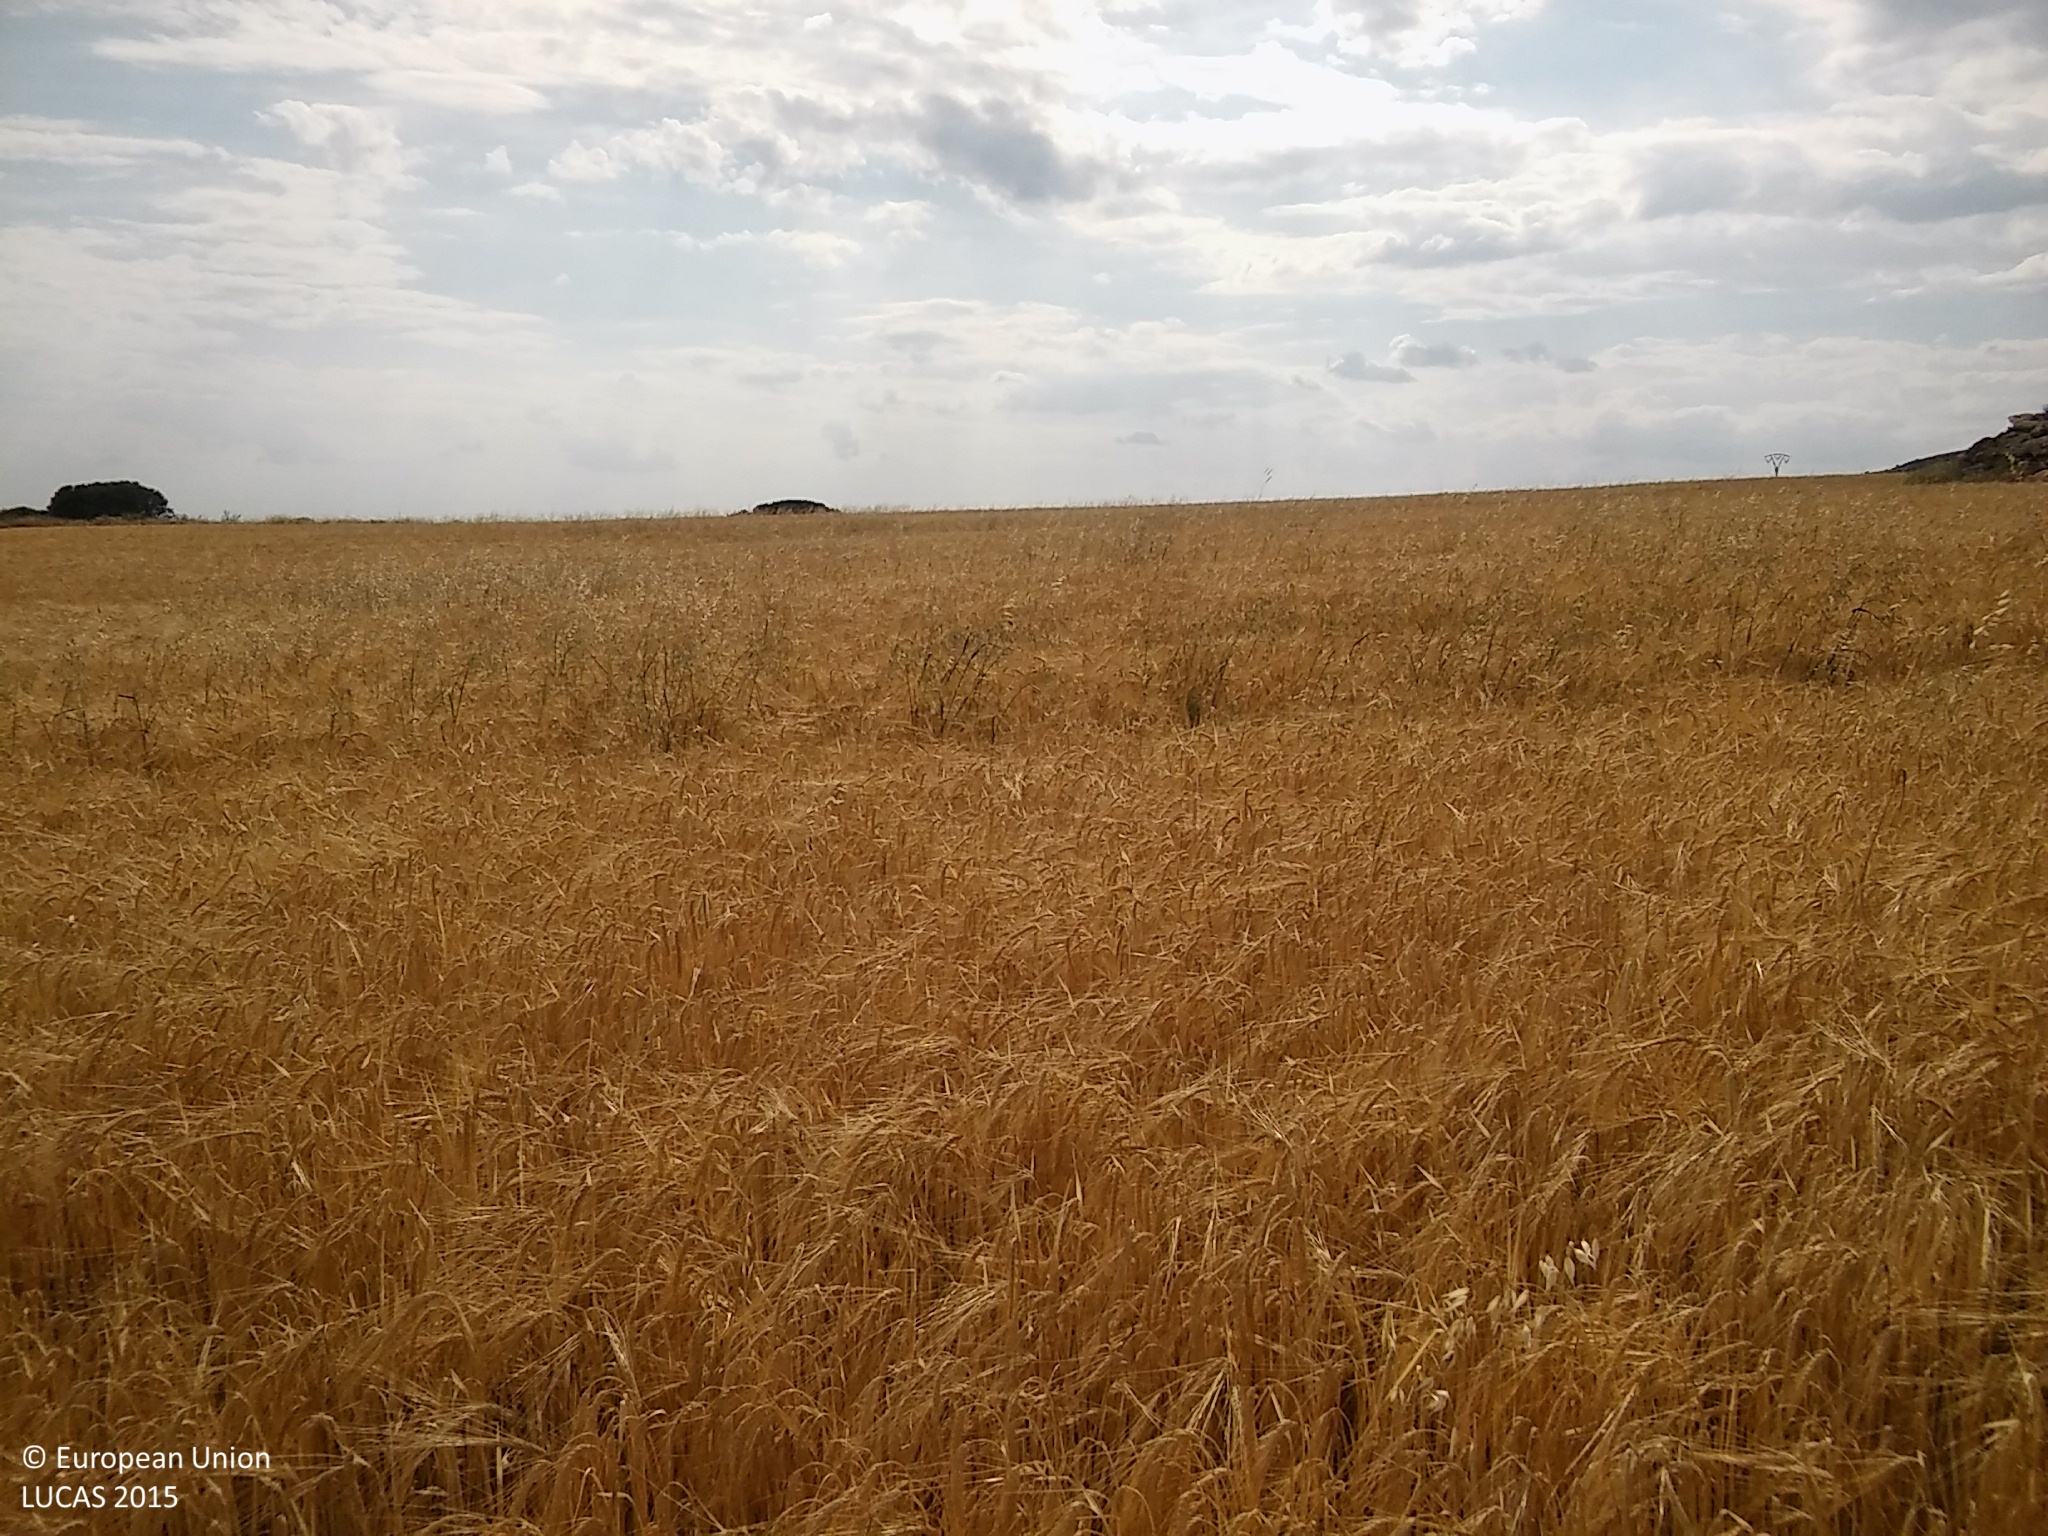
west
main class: Cropland
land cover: Barley
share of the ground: > 75 %
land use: Agriculture (excluding fallow land and kitchen gardens)
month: June
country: ES
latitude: 41.3409
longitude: -3.7811
